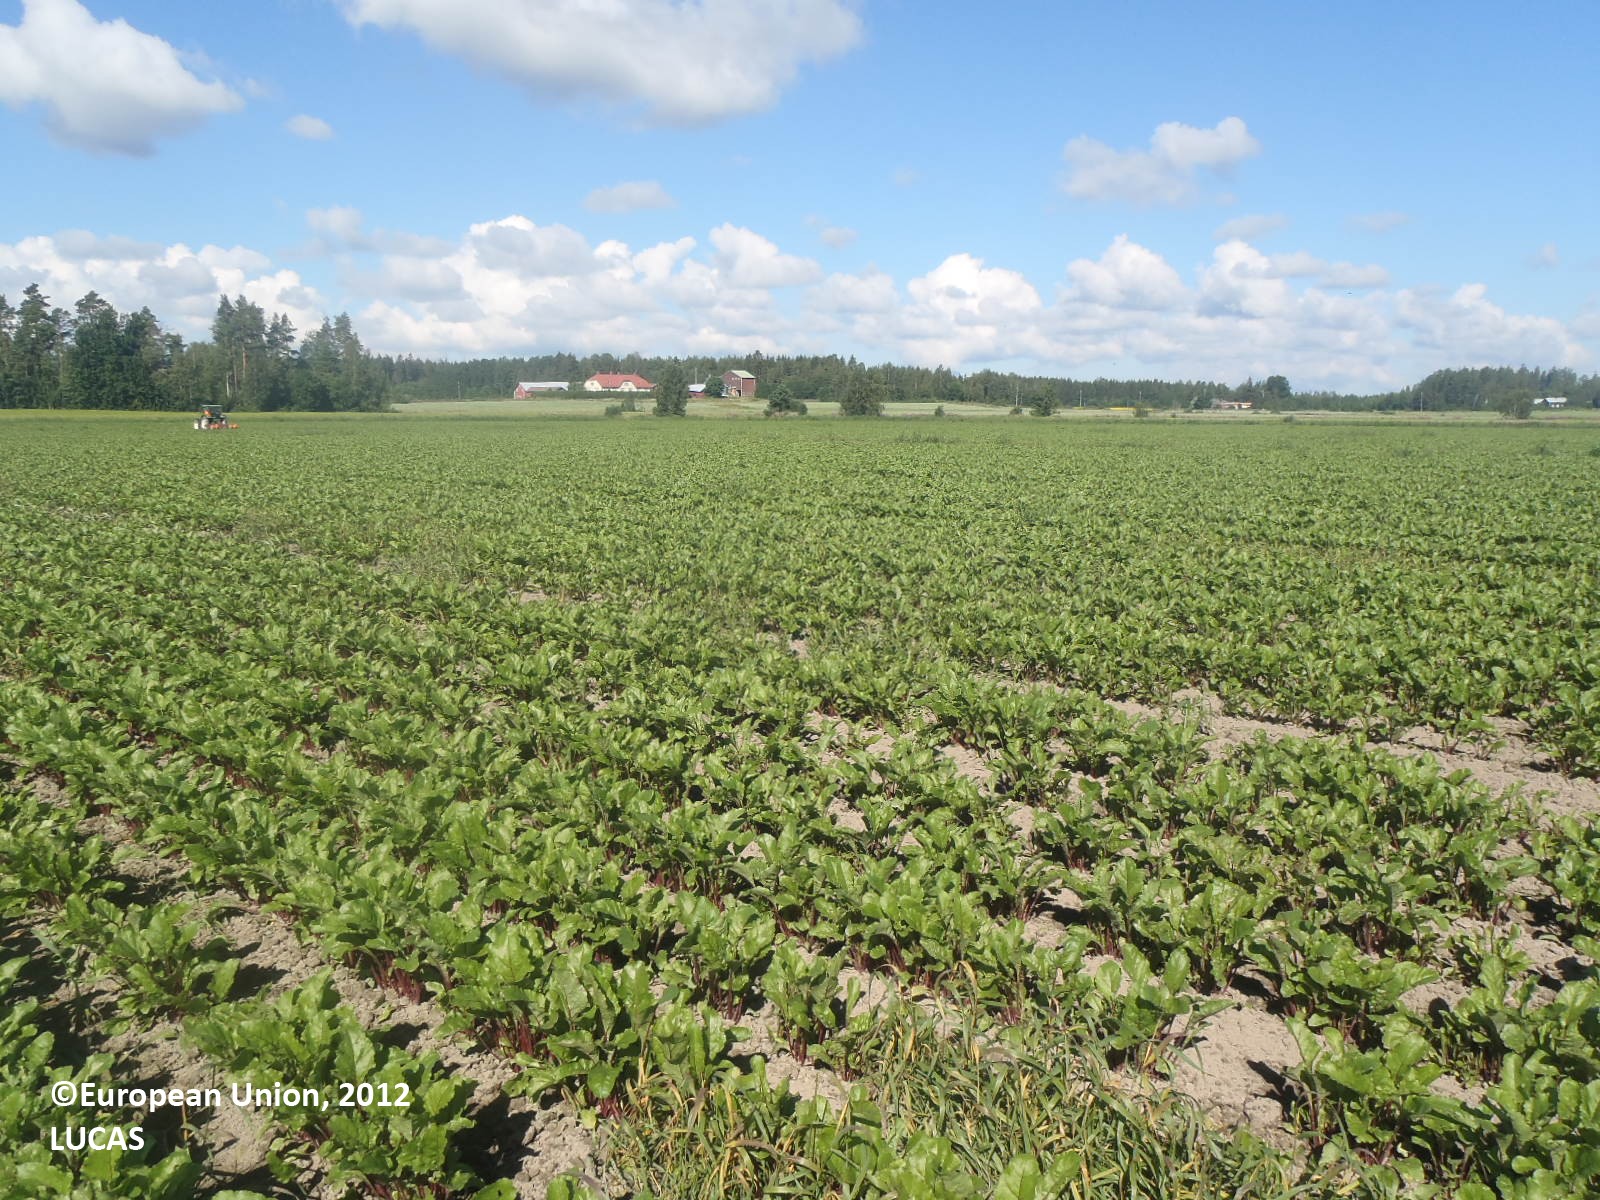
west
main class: Cropland
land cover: Other root crops
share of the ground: 50 - 75 %
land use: Agriculture (excluding fallow land and kitchen gardens)
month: July
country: FI
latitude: 61.0024
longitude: 21.9498
